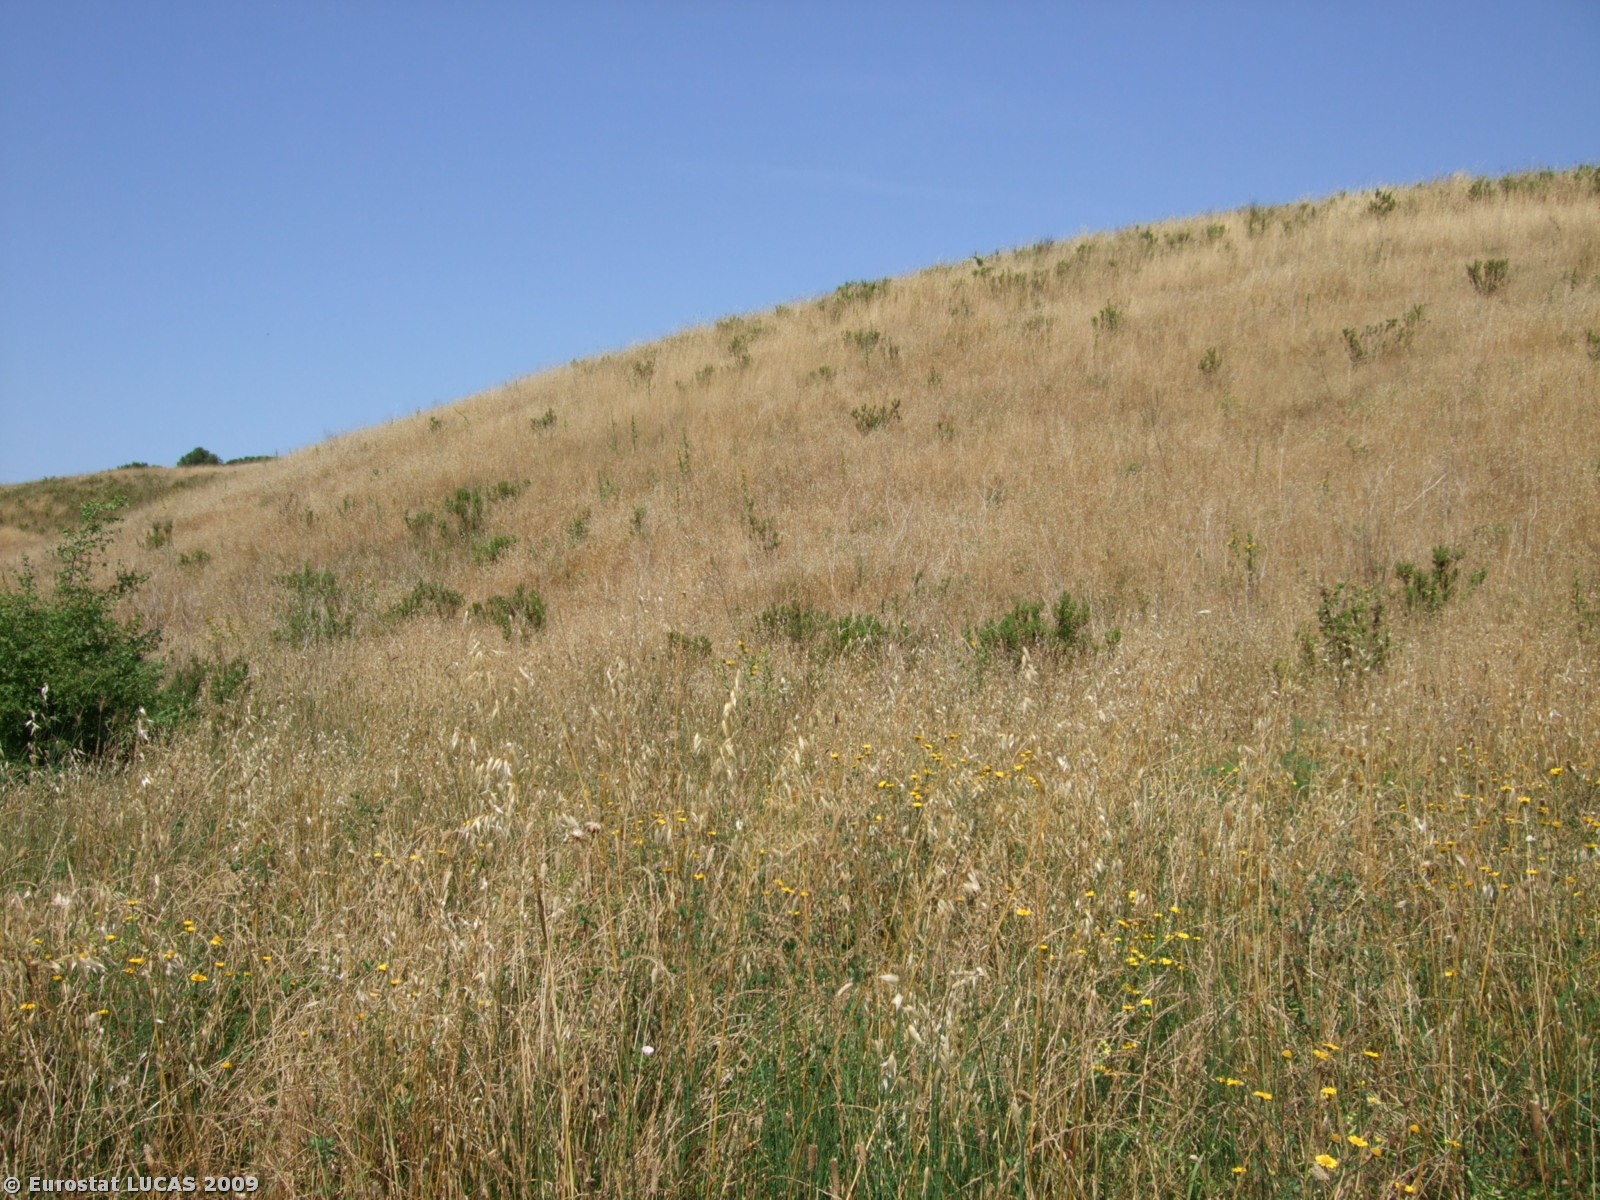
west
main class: Grassland
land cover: Grassland without tree/shrub cover
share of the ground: > 75 %
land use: Fallow land
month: June
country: IT
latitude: 41.8504
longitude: 12.3158
